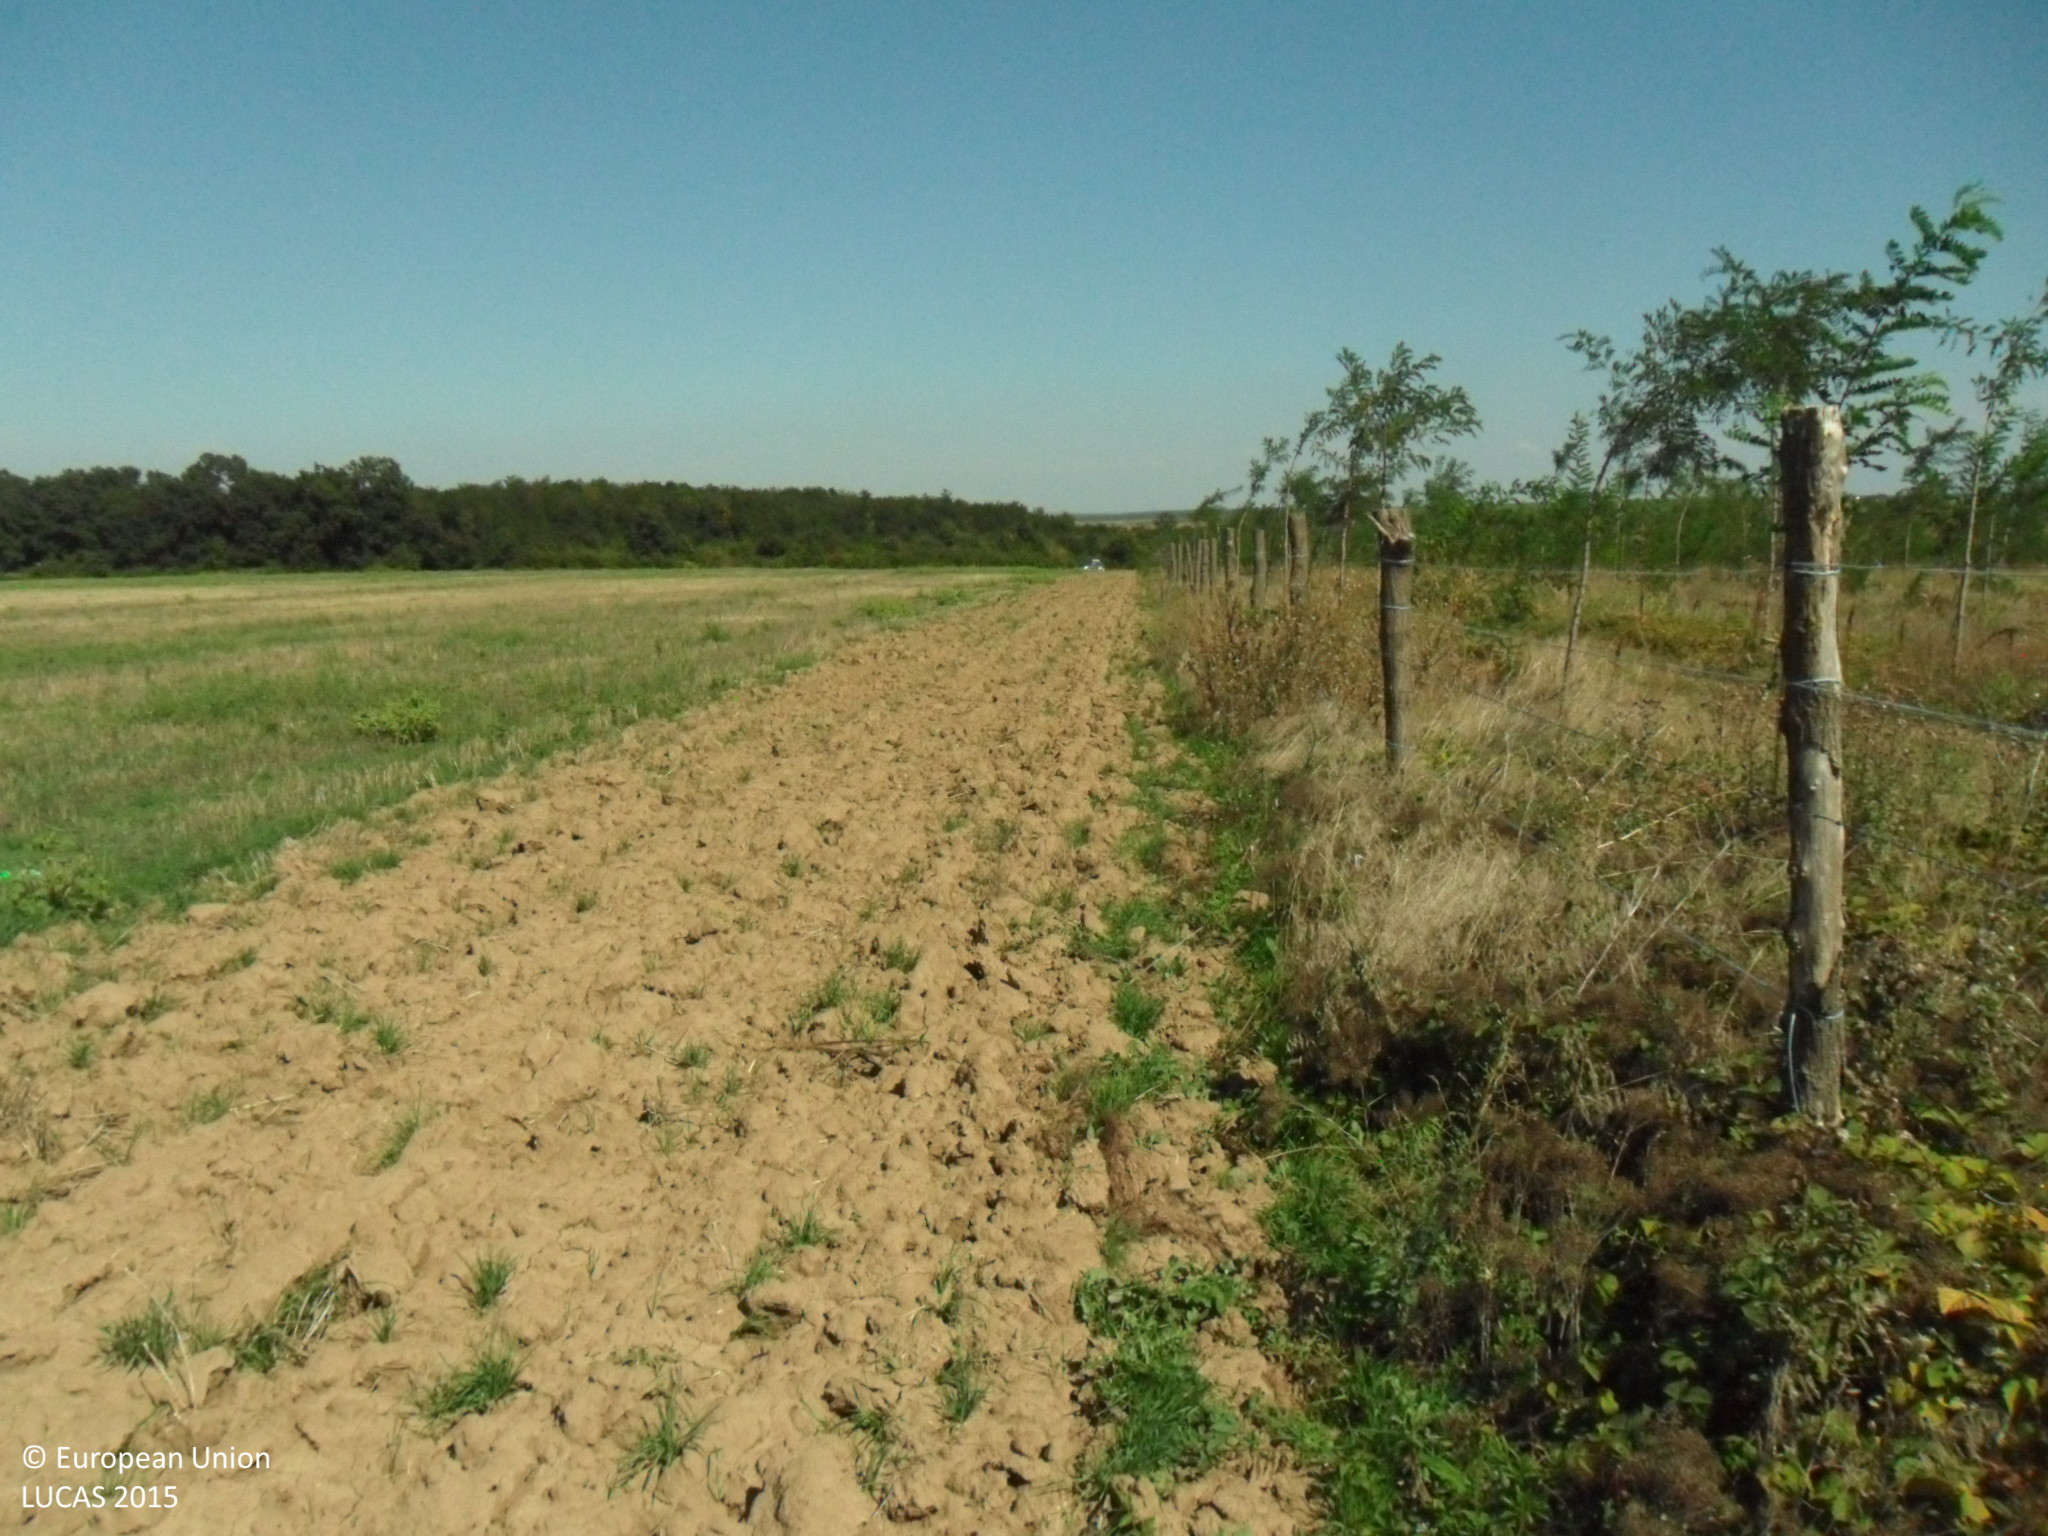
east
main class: Cropland
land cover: Nurseries
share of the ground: 50 - 75 %
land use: Forestry
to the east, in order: Nurseries
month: September
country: BG
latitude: 43.5686
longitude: 27.1722
